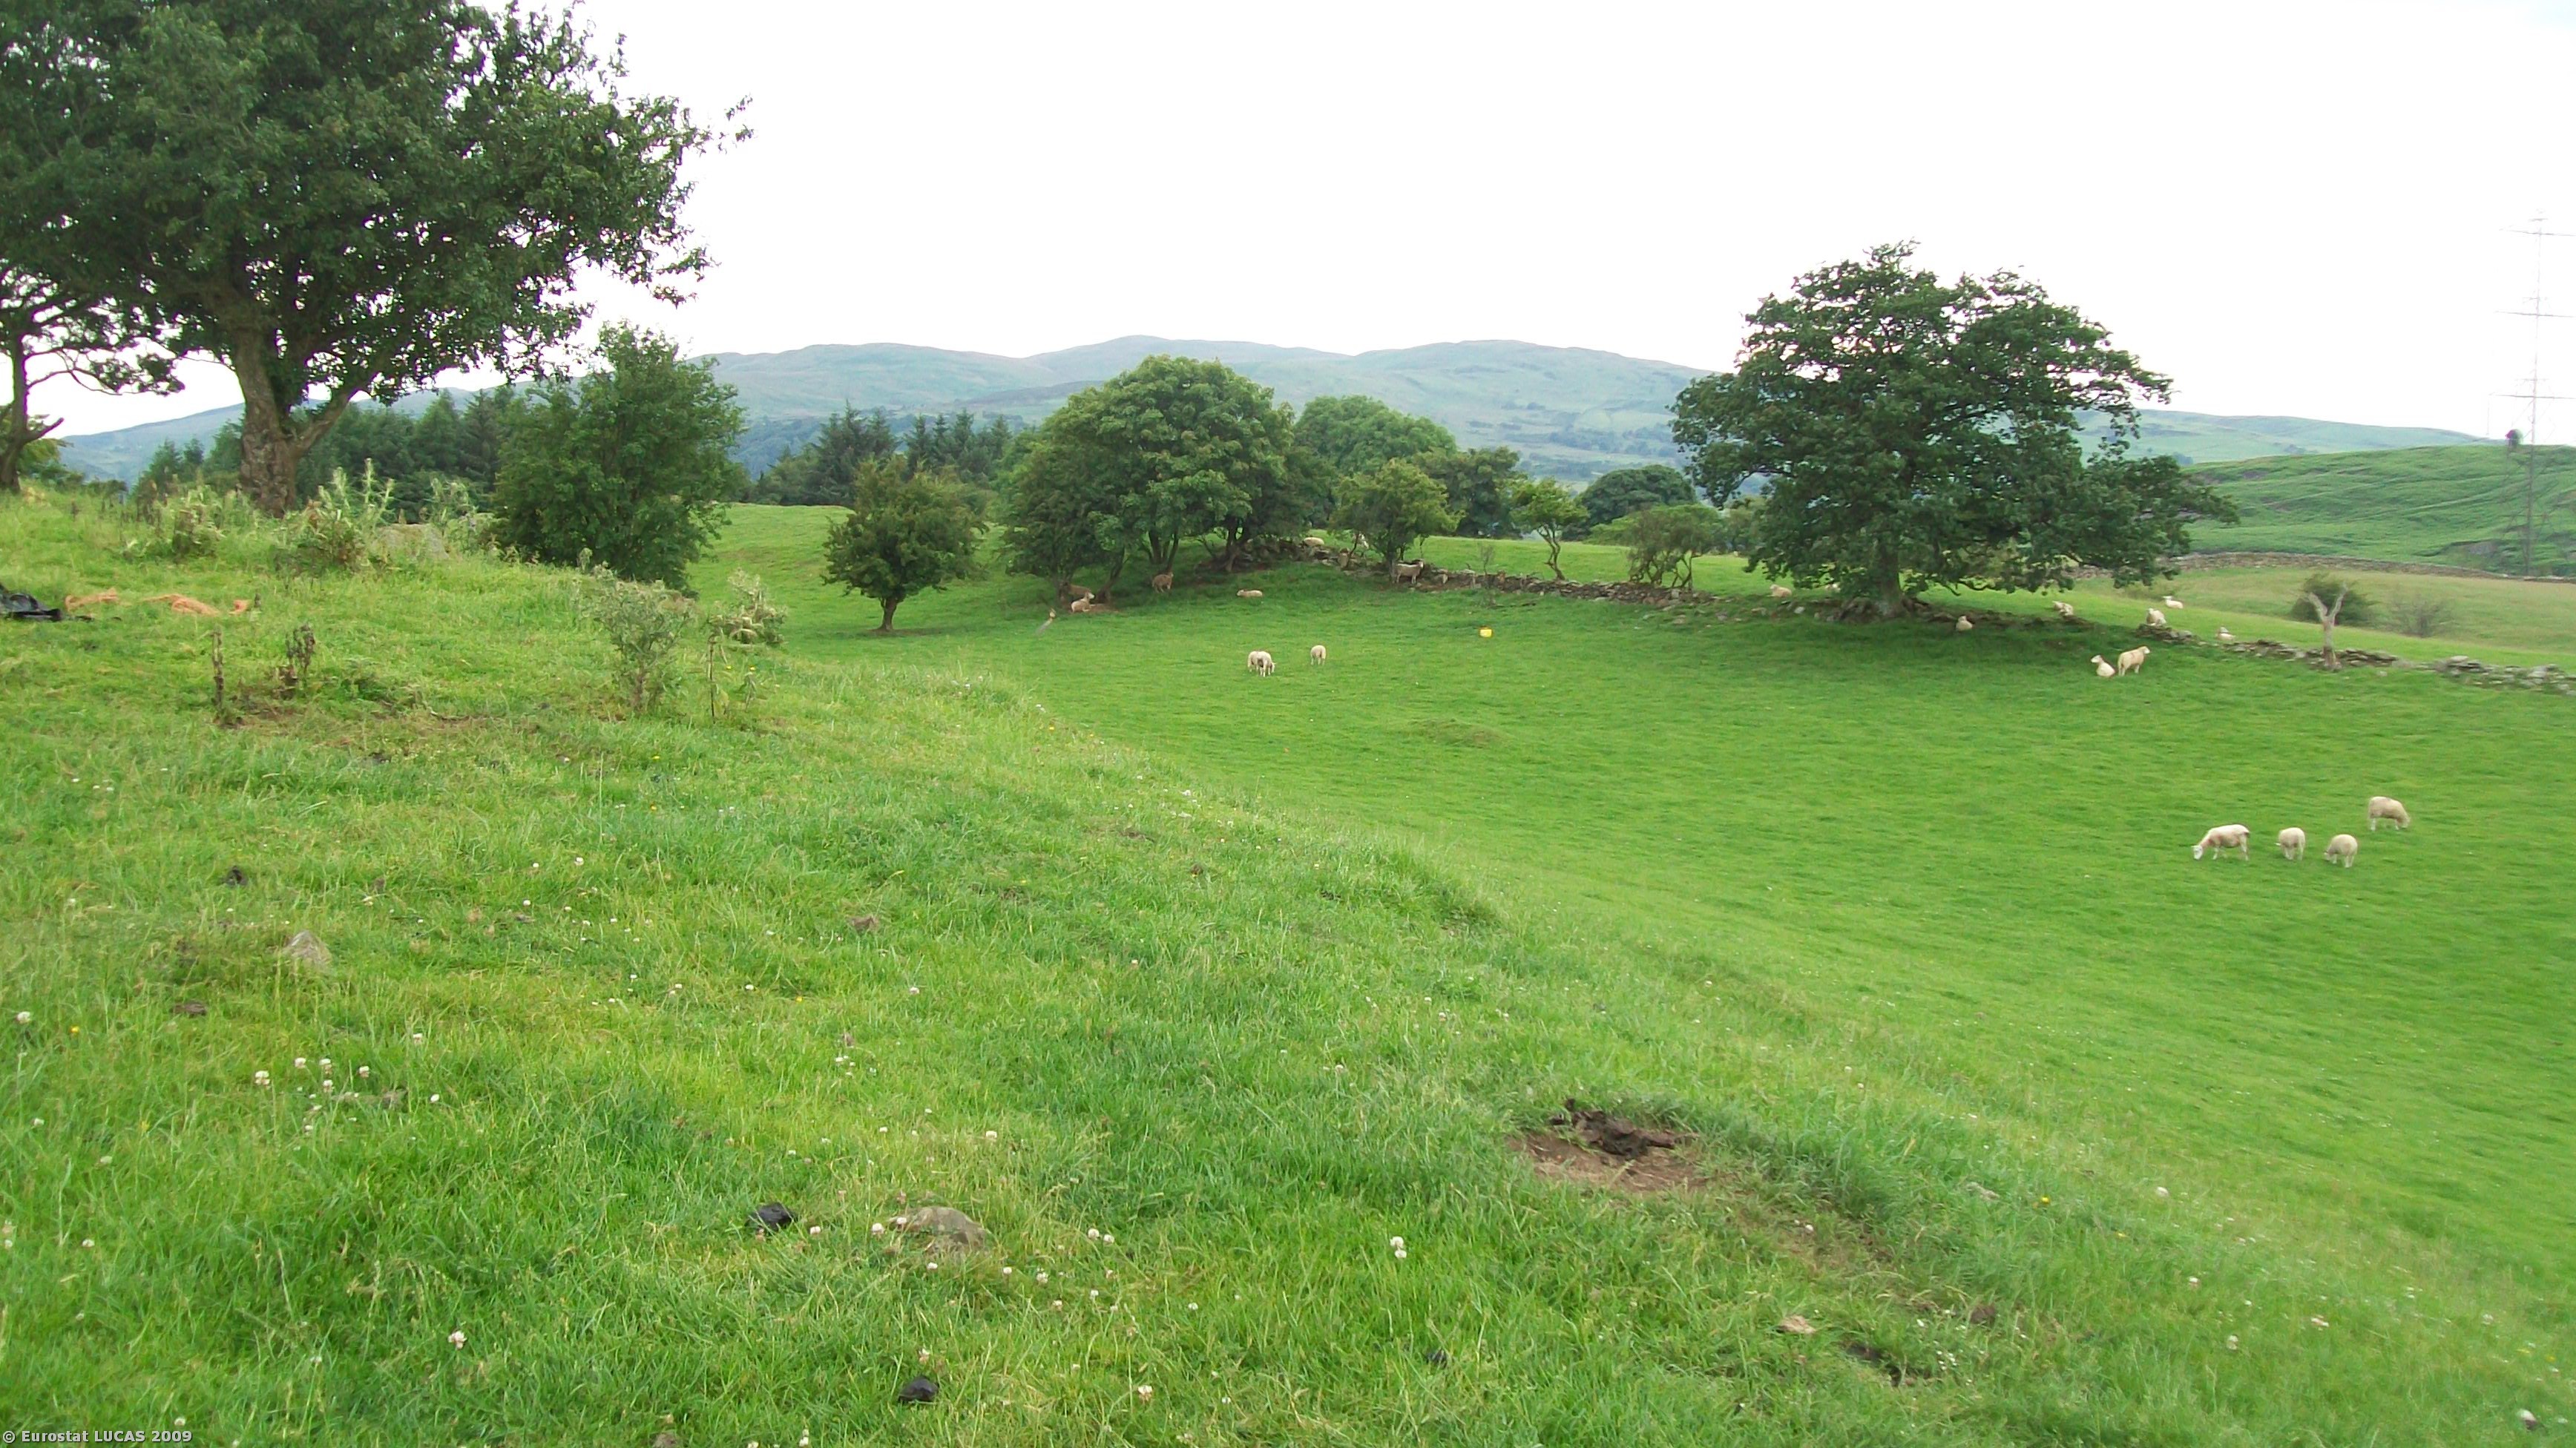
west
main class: Grassland
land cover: Grassland without tree/shrub cover
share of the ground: > 75 %
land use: Agriculture (excluding fallow land and kitchen gardens)
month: July
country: GB
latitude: 52.9730
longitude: -3.4708
